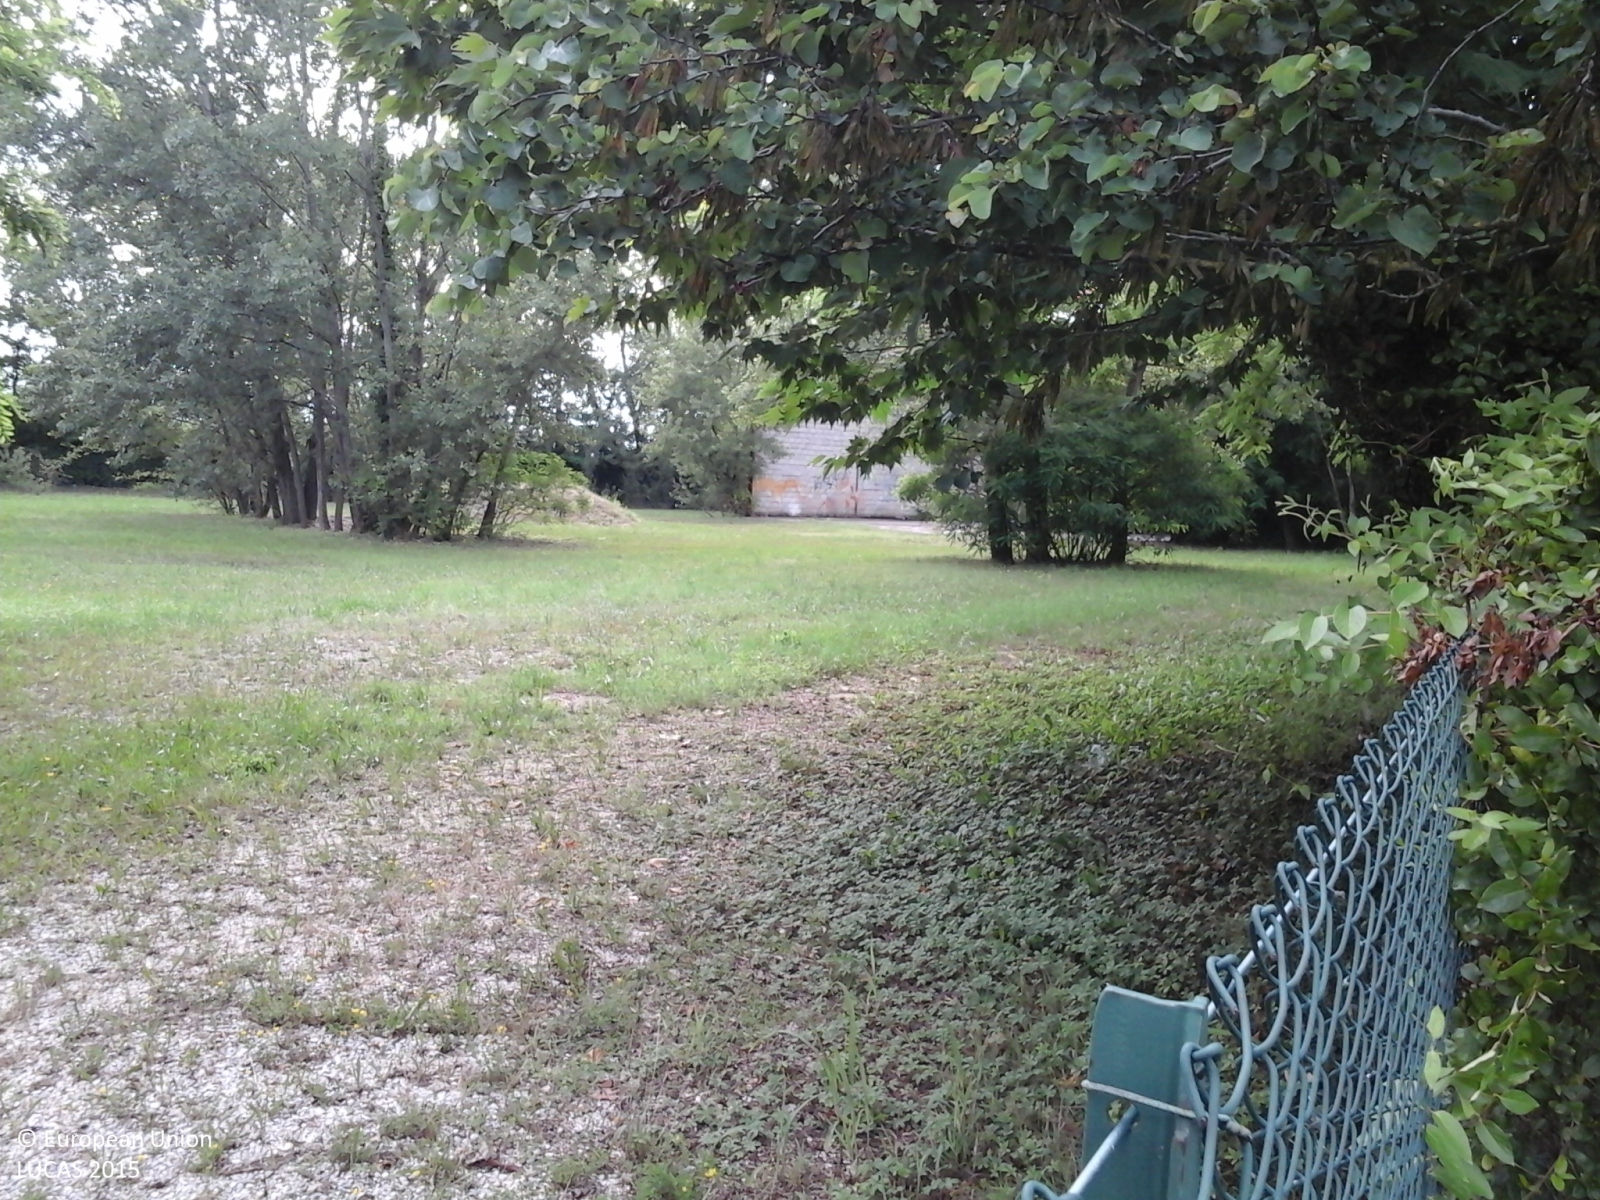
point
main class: Artificial land
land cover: Non built-up linear features
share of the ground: > 75 %
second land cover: Grassland without tree/shrub cover
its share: 10 - 25 %
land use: Road transport
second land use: Agriculture (excluding fallow land and kitchen gardens)
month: June
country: IT
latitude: 45.7673
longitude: 12.3241
